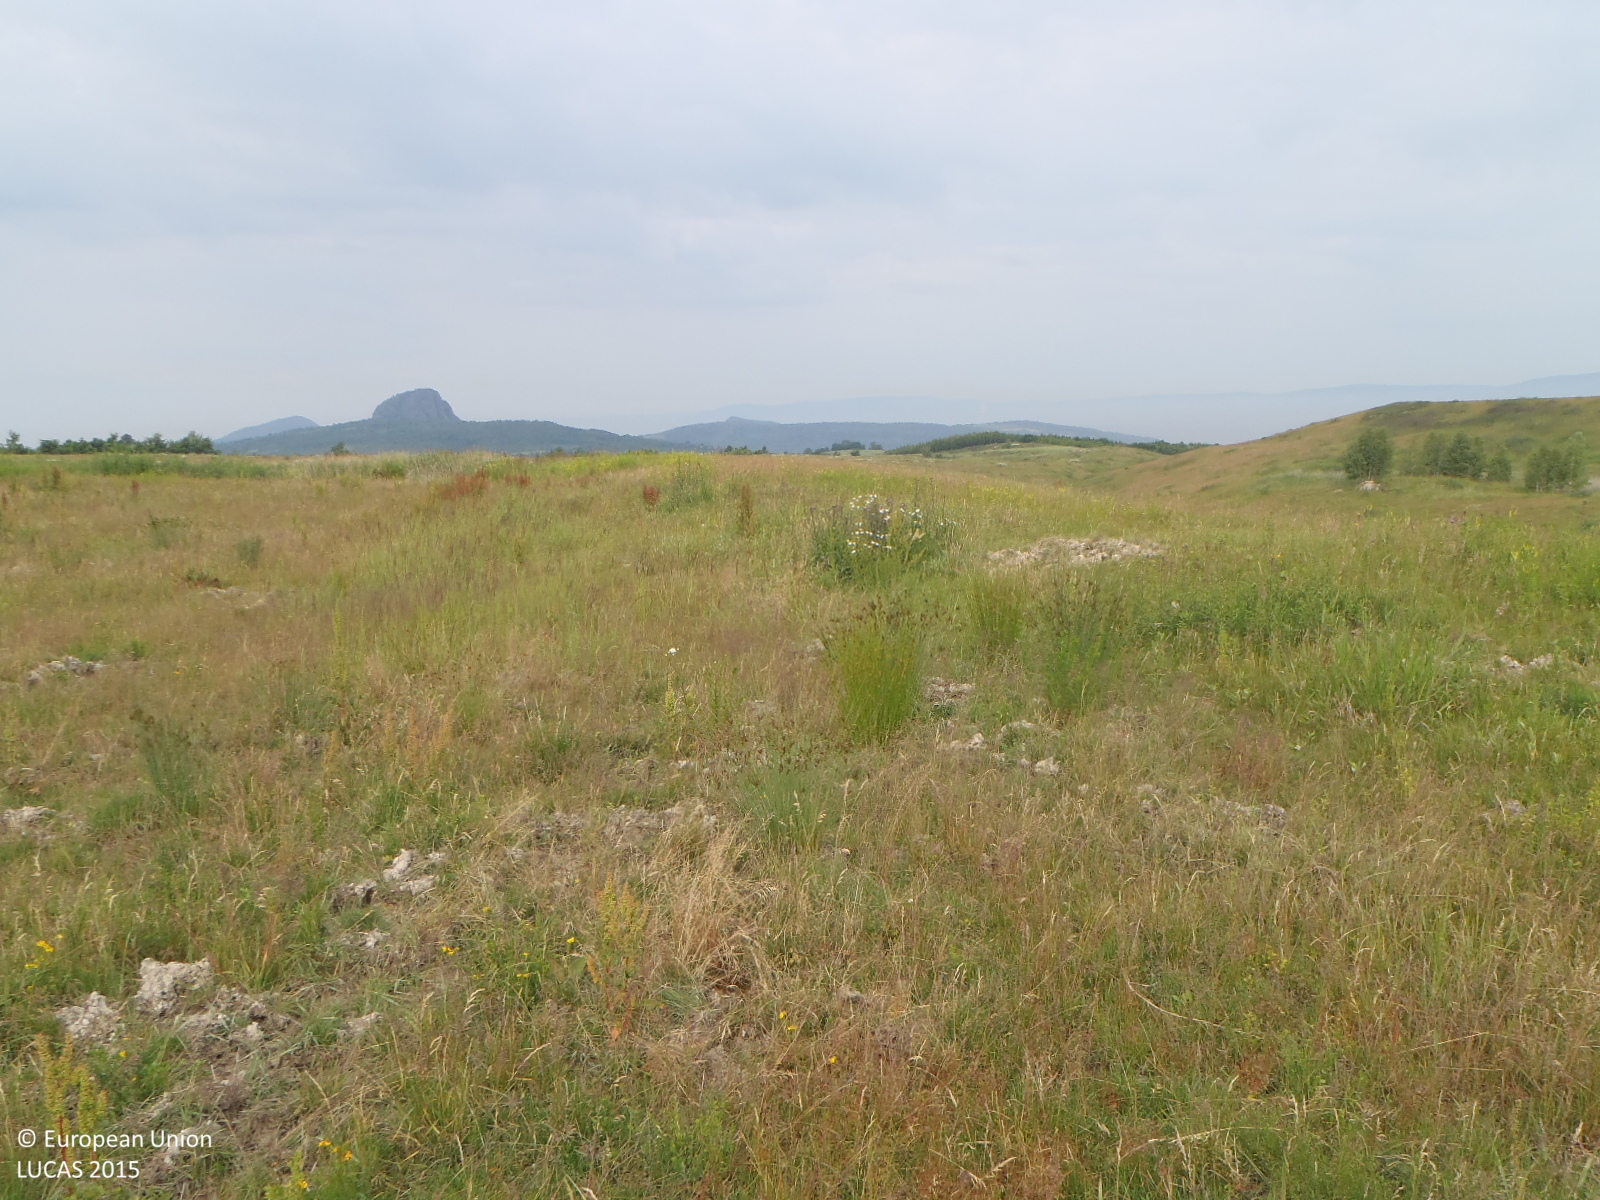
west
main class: Grassland
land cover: Grassland without tree/shrub cover
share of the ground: > 75 %
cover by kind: herbaceous plants 95 %, unconsolidated bare surface 5 %
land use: Mining and quarrying
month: June
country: CZ
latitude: 50.5342
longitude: 13.8242
